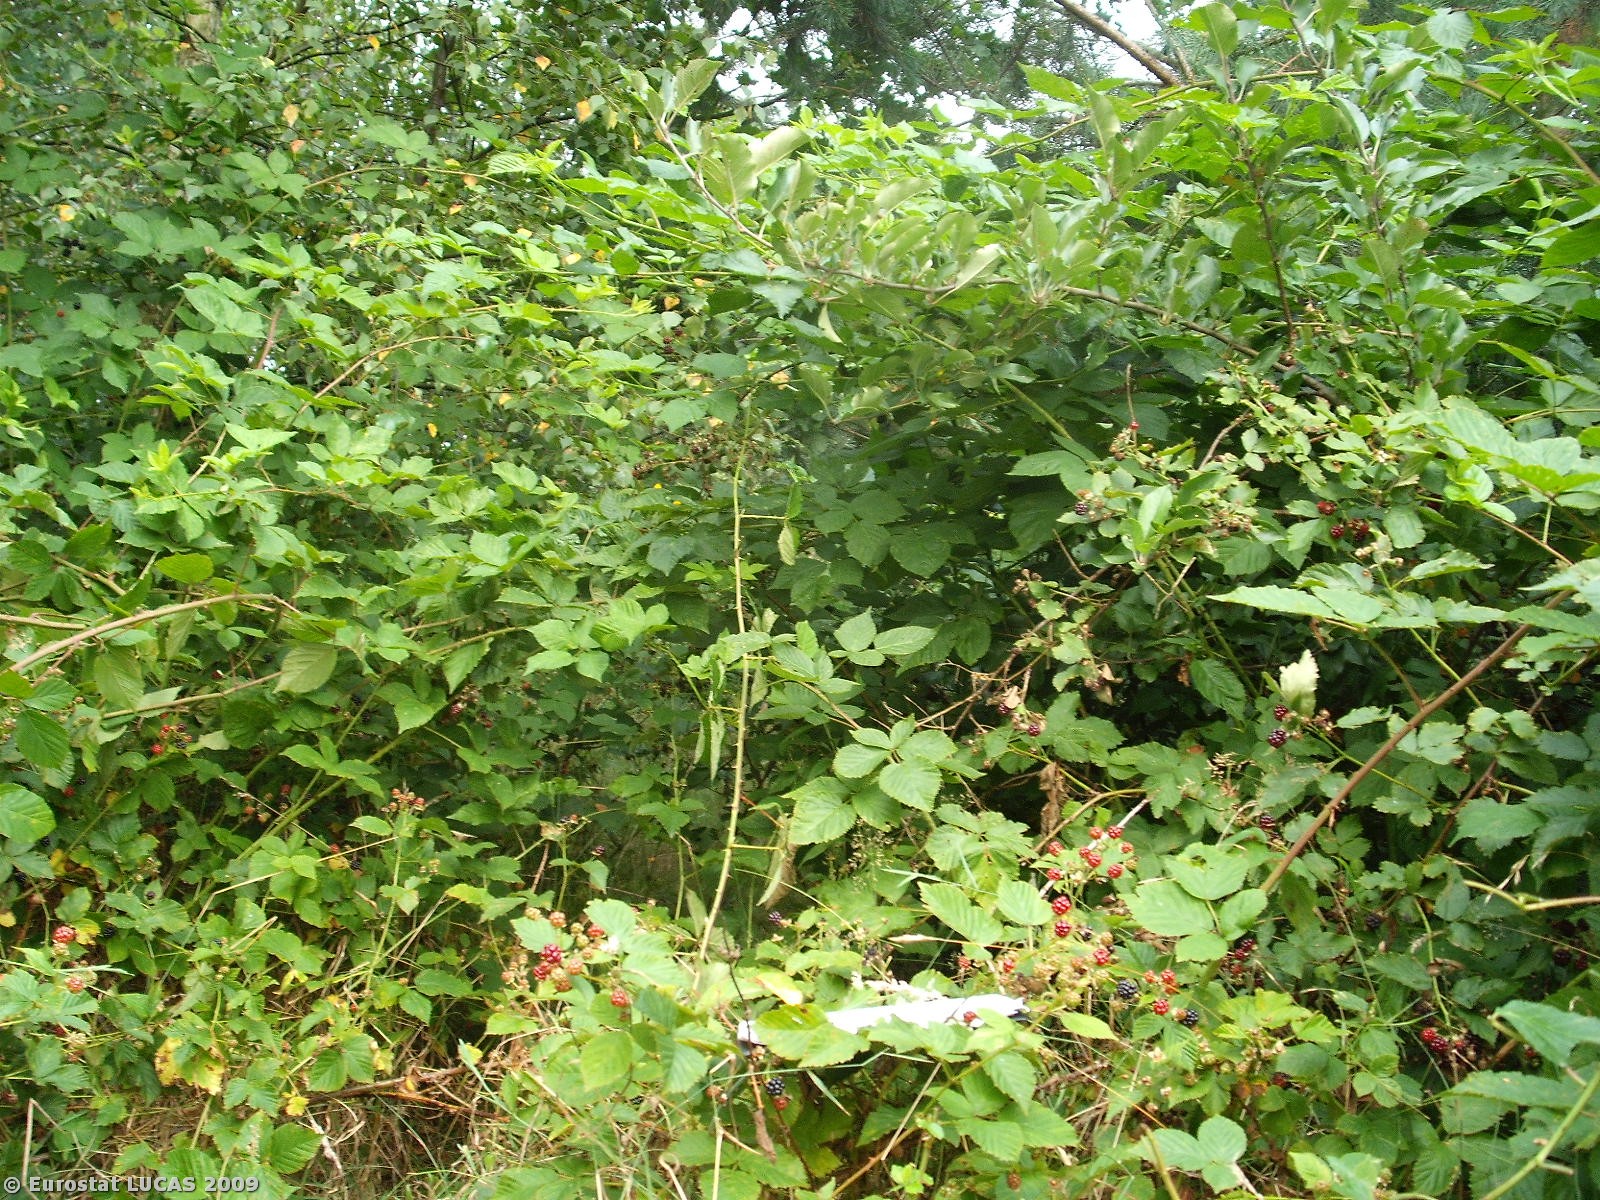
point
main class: Woodland
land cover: Mixed woodland
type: hemiboreal forest and nemoral coniferous forest and mixed broadleaved-coniferous forest
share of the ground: > 75 %
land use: Unused
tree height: > 5 m
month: August
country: PL
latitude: 50.0354
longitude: 21.1448
